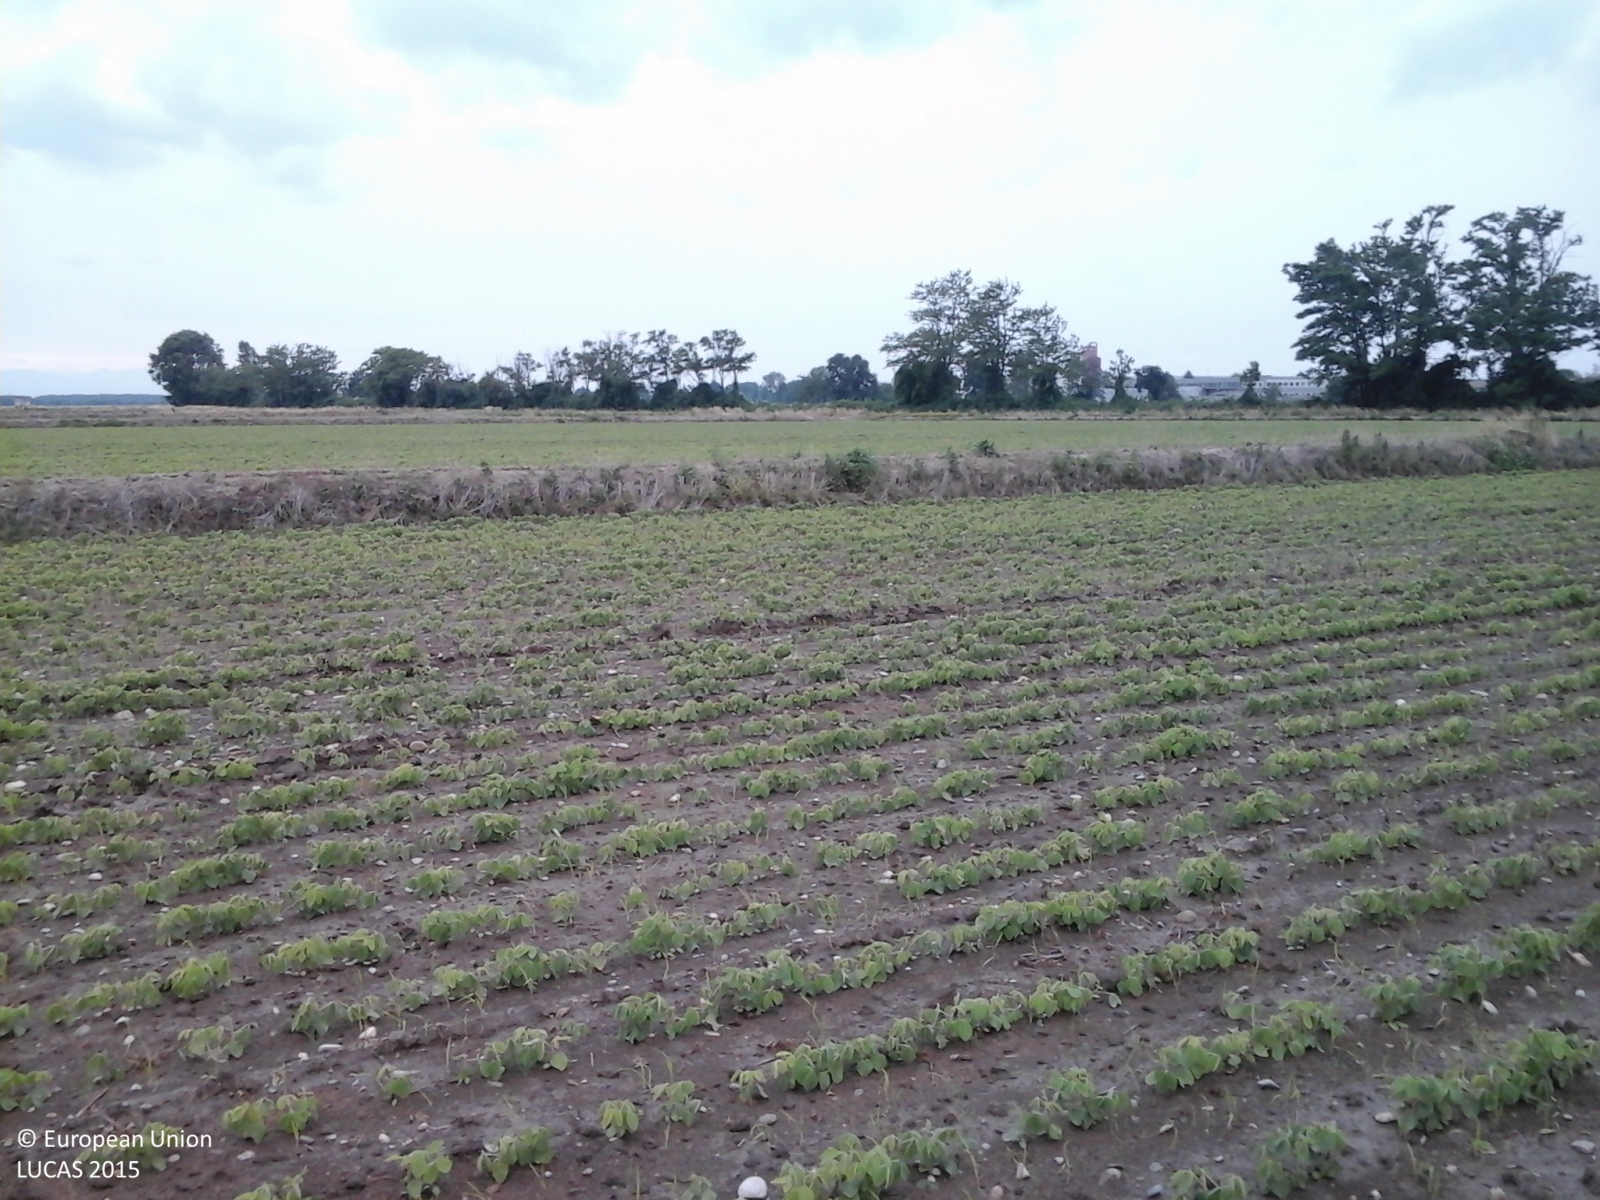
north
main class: Cropland
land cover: Soya
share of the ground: 10 - 25 %
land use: Agriculture (excluding fallow land and kitchen gardens)
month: May
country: IT
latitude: 45.4405
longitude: 8.5578
